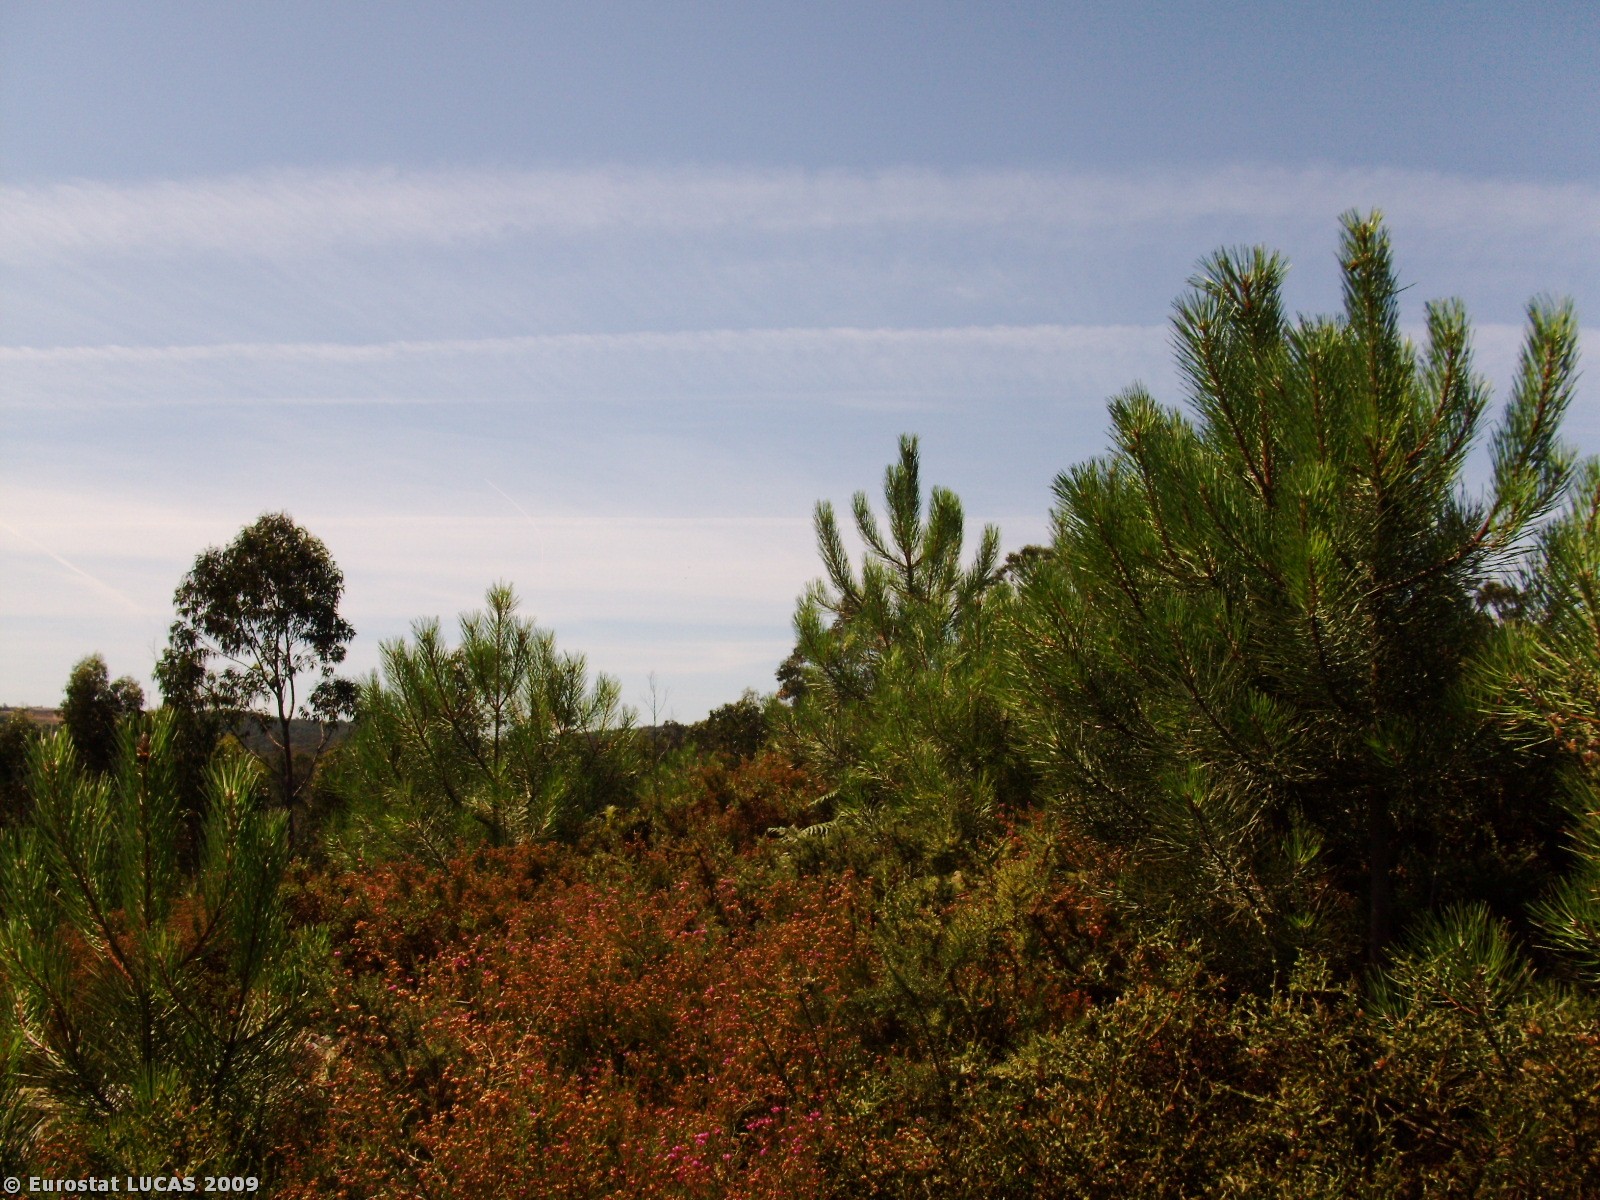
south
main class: Shrubland
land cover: Shrubland without tree cover
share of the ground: > 75 %
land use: Forestry
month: July
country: PT
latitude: 41.3351
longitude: -8.5190
